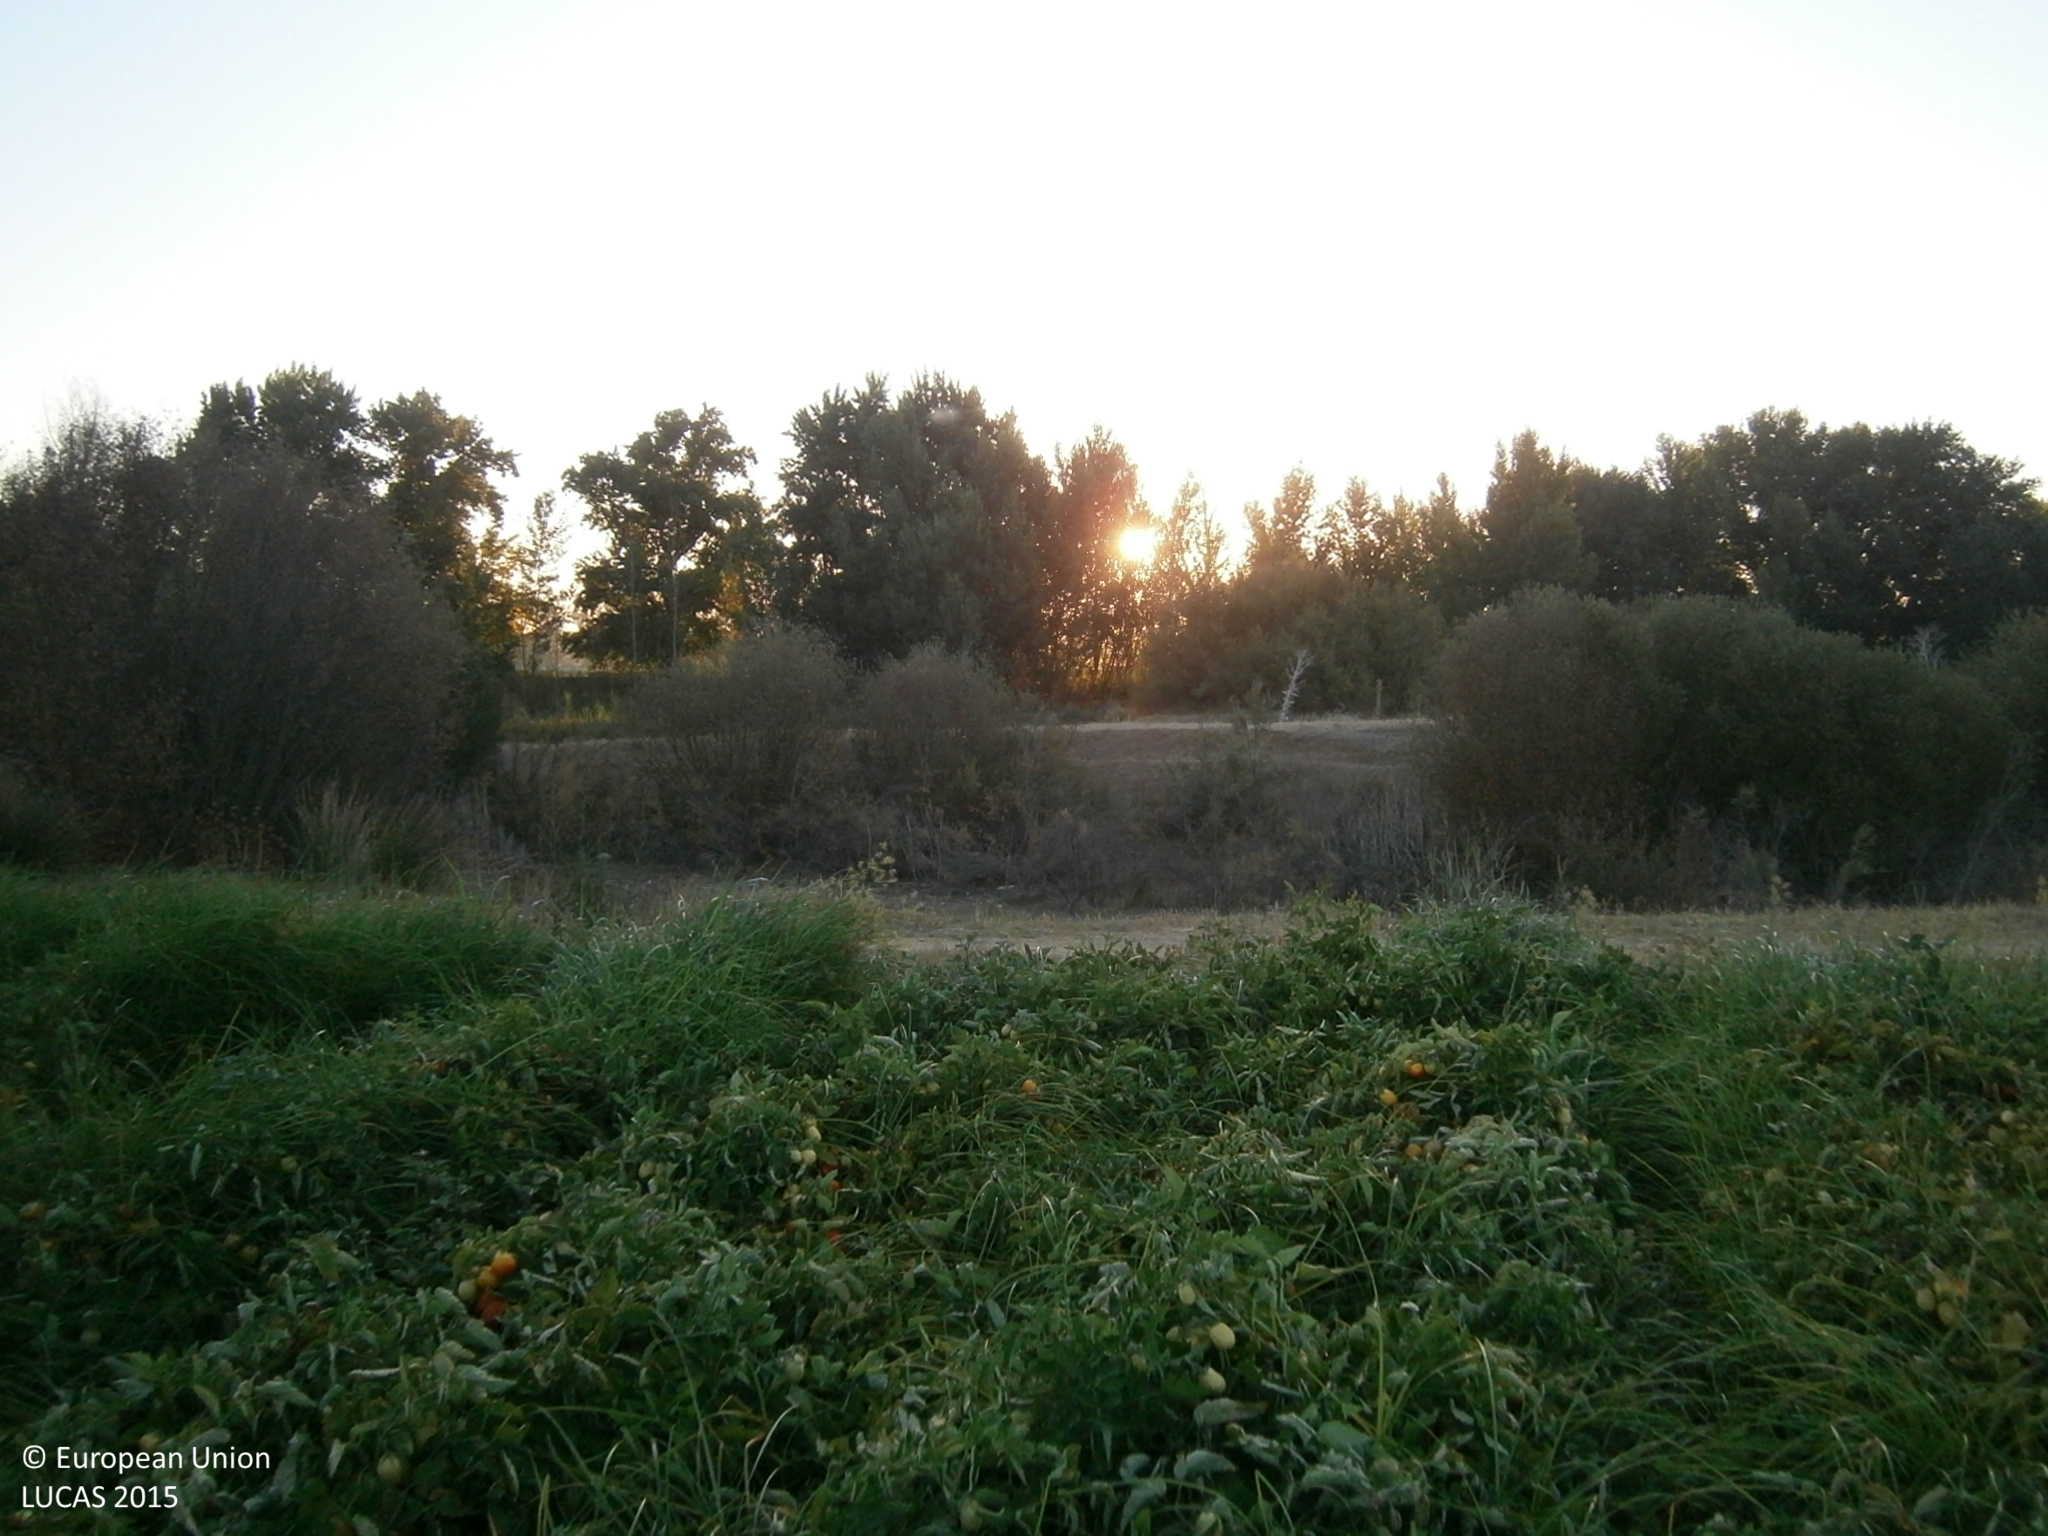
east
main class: Cropland
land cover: Tomatoes
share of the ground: > 75 %
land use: Agriculture (excluding fallow land and kitchen gardens)
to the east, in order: Tomatoes; Tracks; Shrubland with sparse tree cover; Lucerne
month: July
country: ES
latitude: 38.9036
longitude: -6.7746
